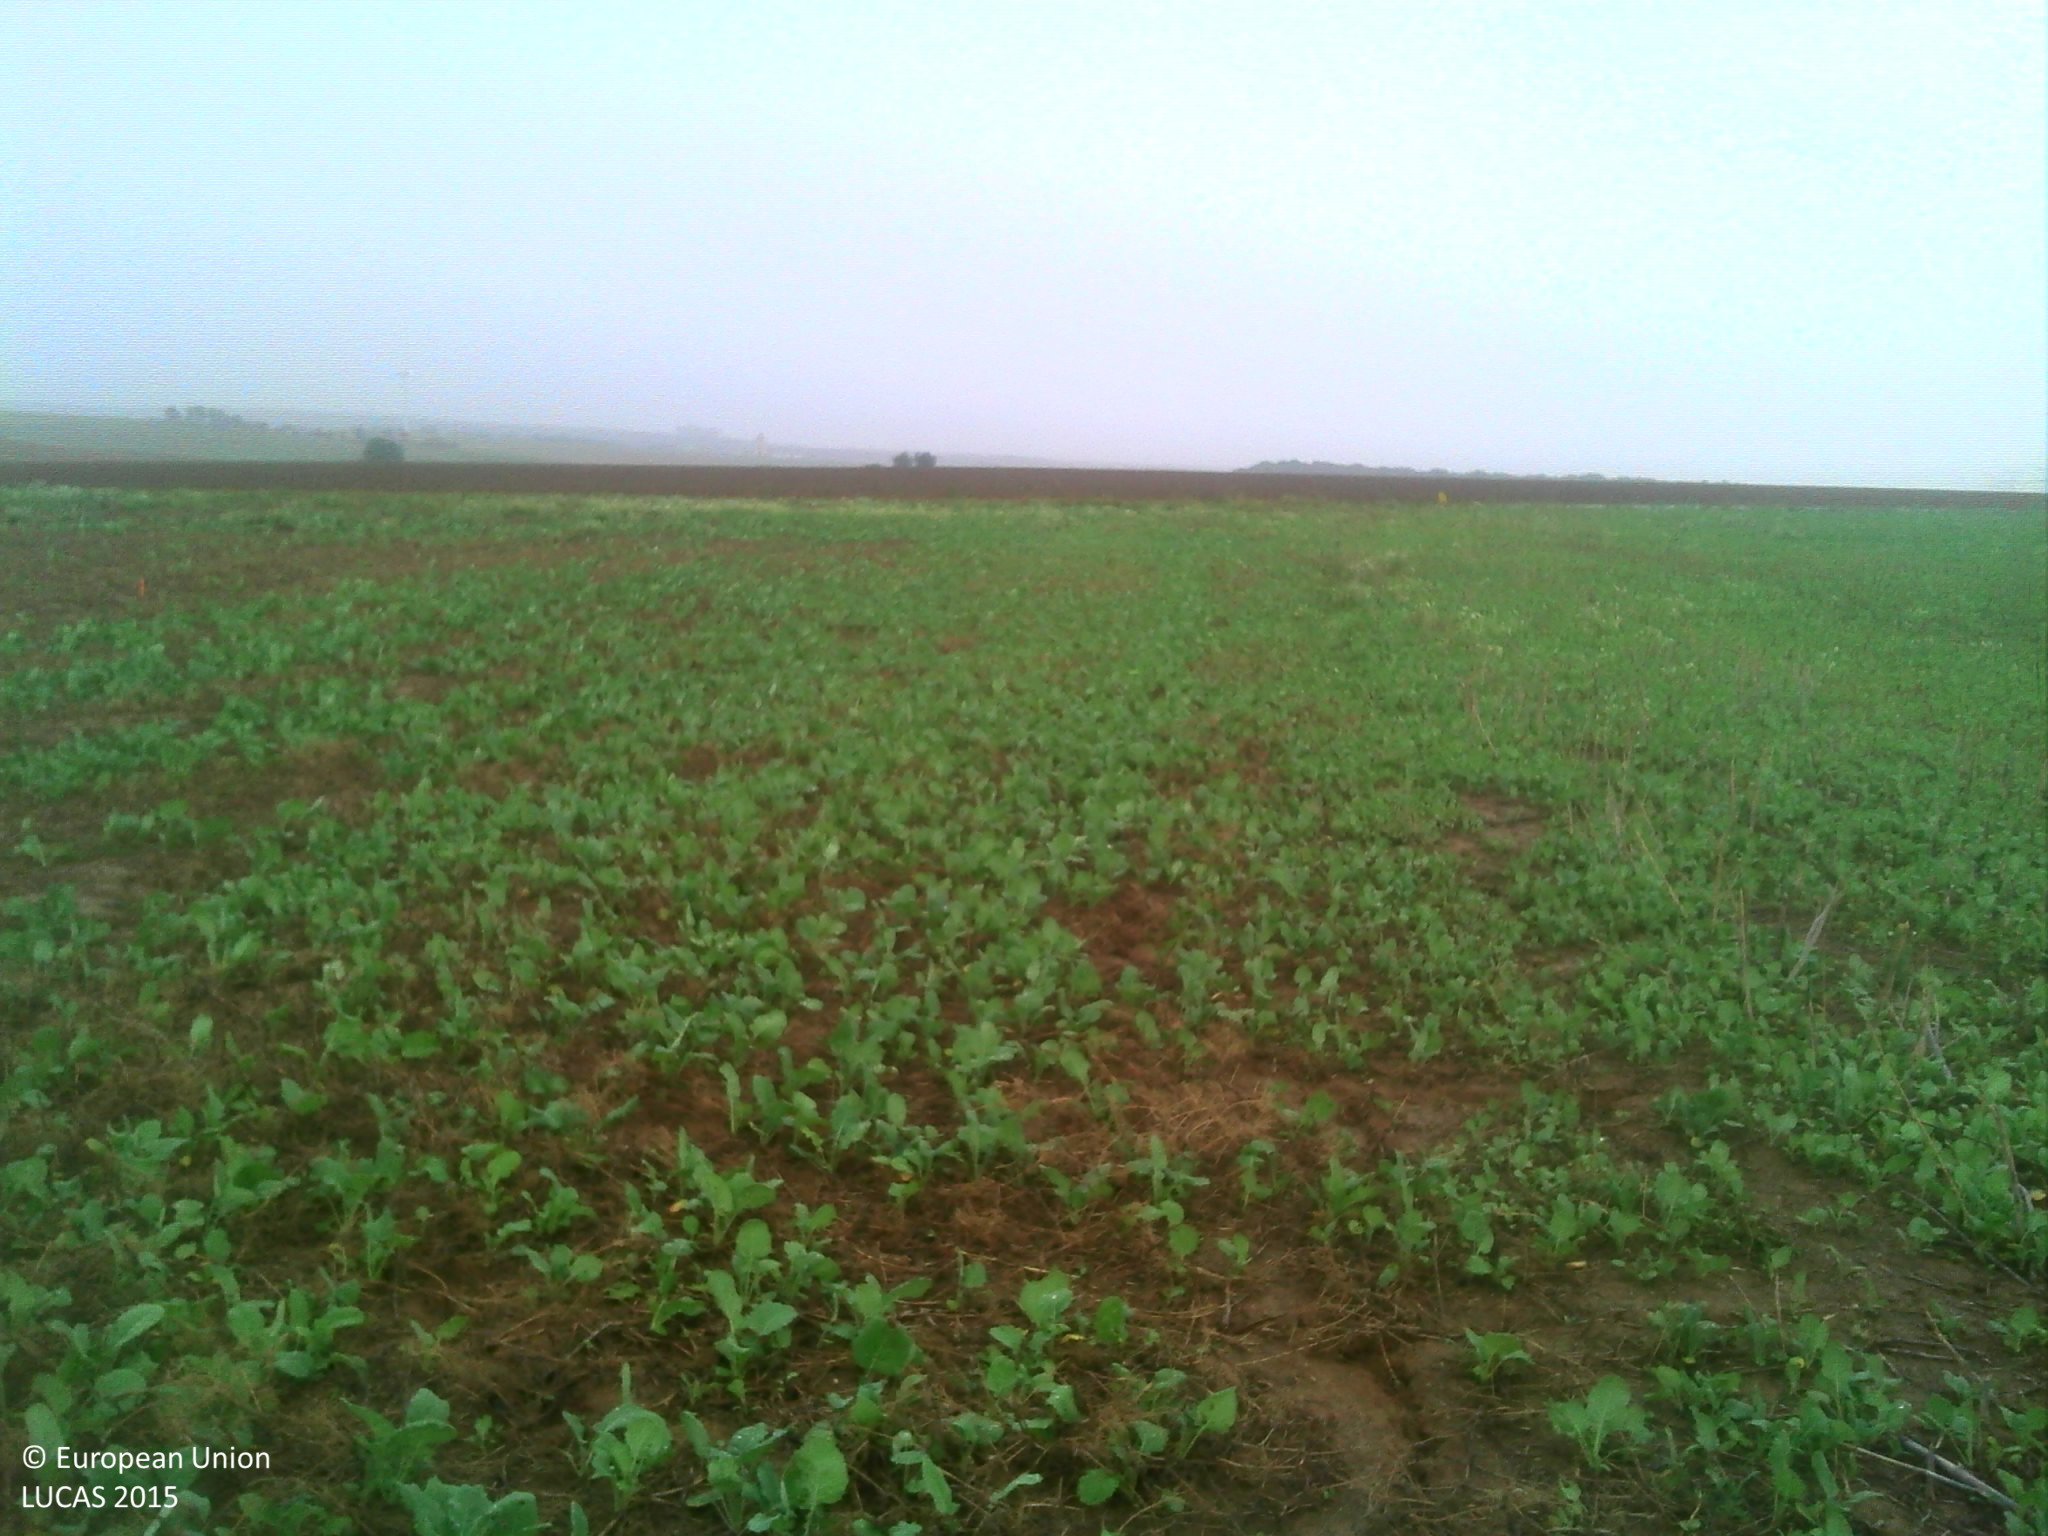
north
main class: Cropland
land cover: Rape and turnip rape
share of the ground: 10 - 25 %
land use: Agriculture (excluding fallow land and kitchen gardens)
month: September
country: FR
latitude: 49.2628
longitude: 5.8630
